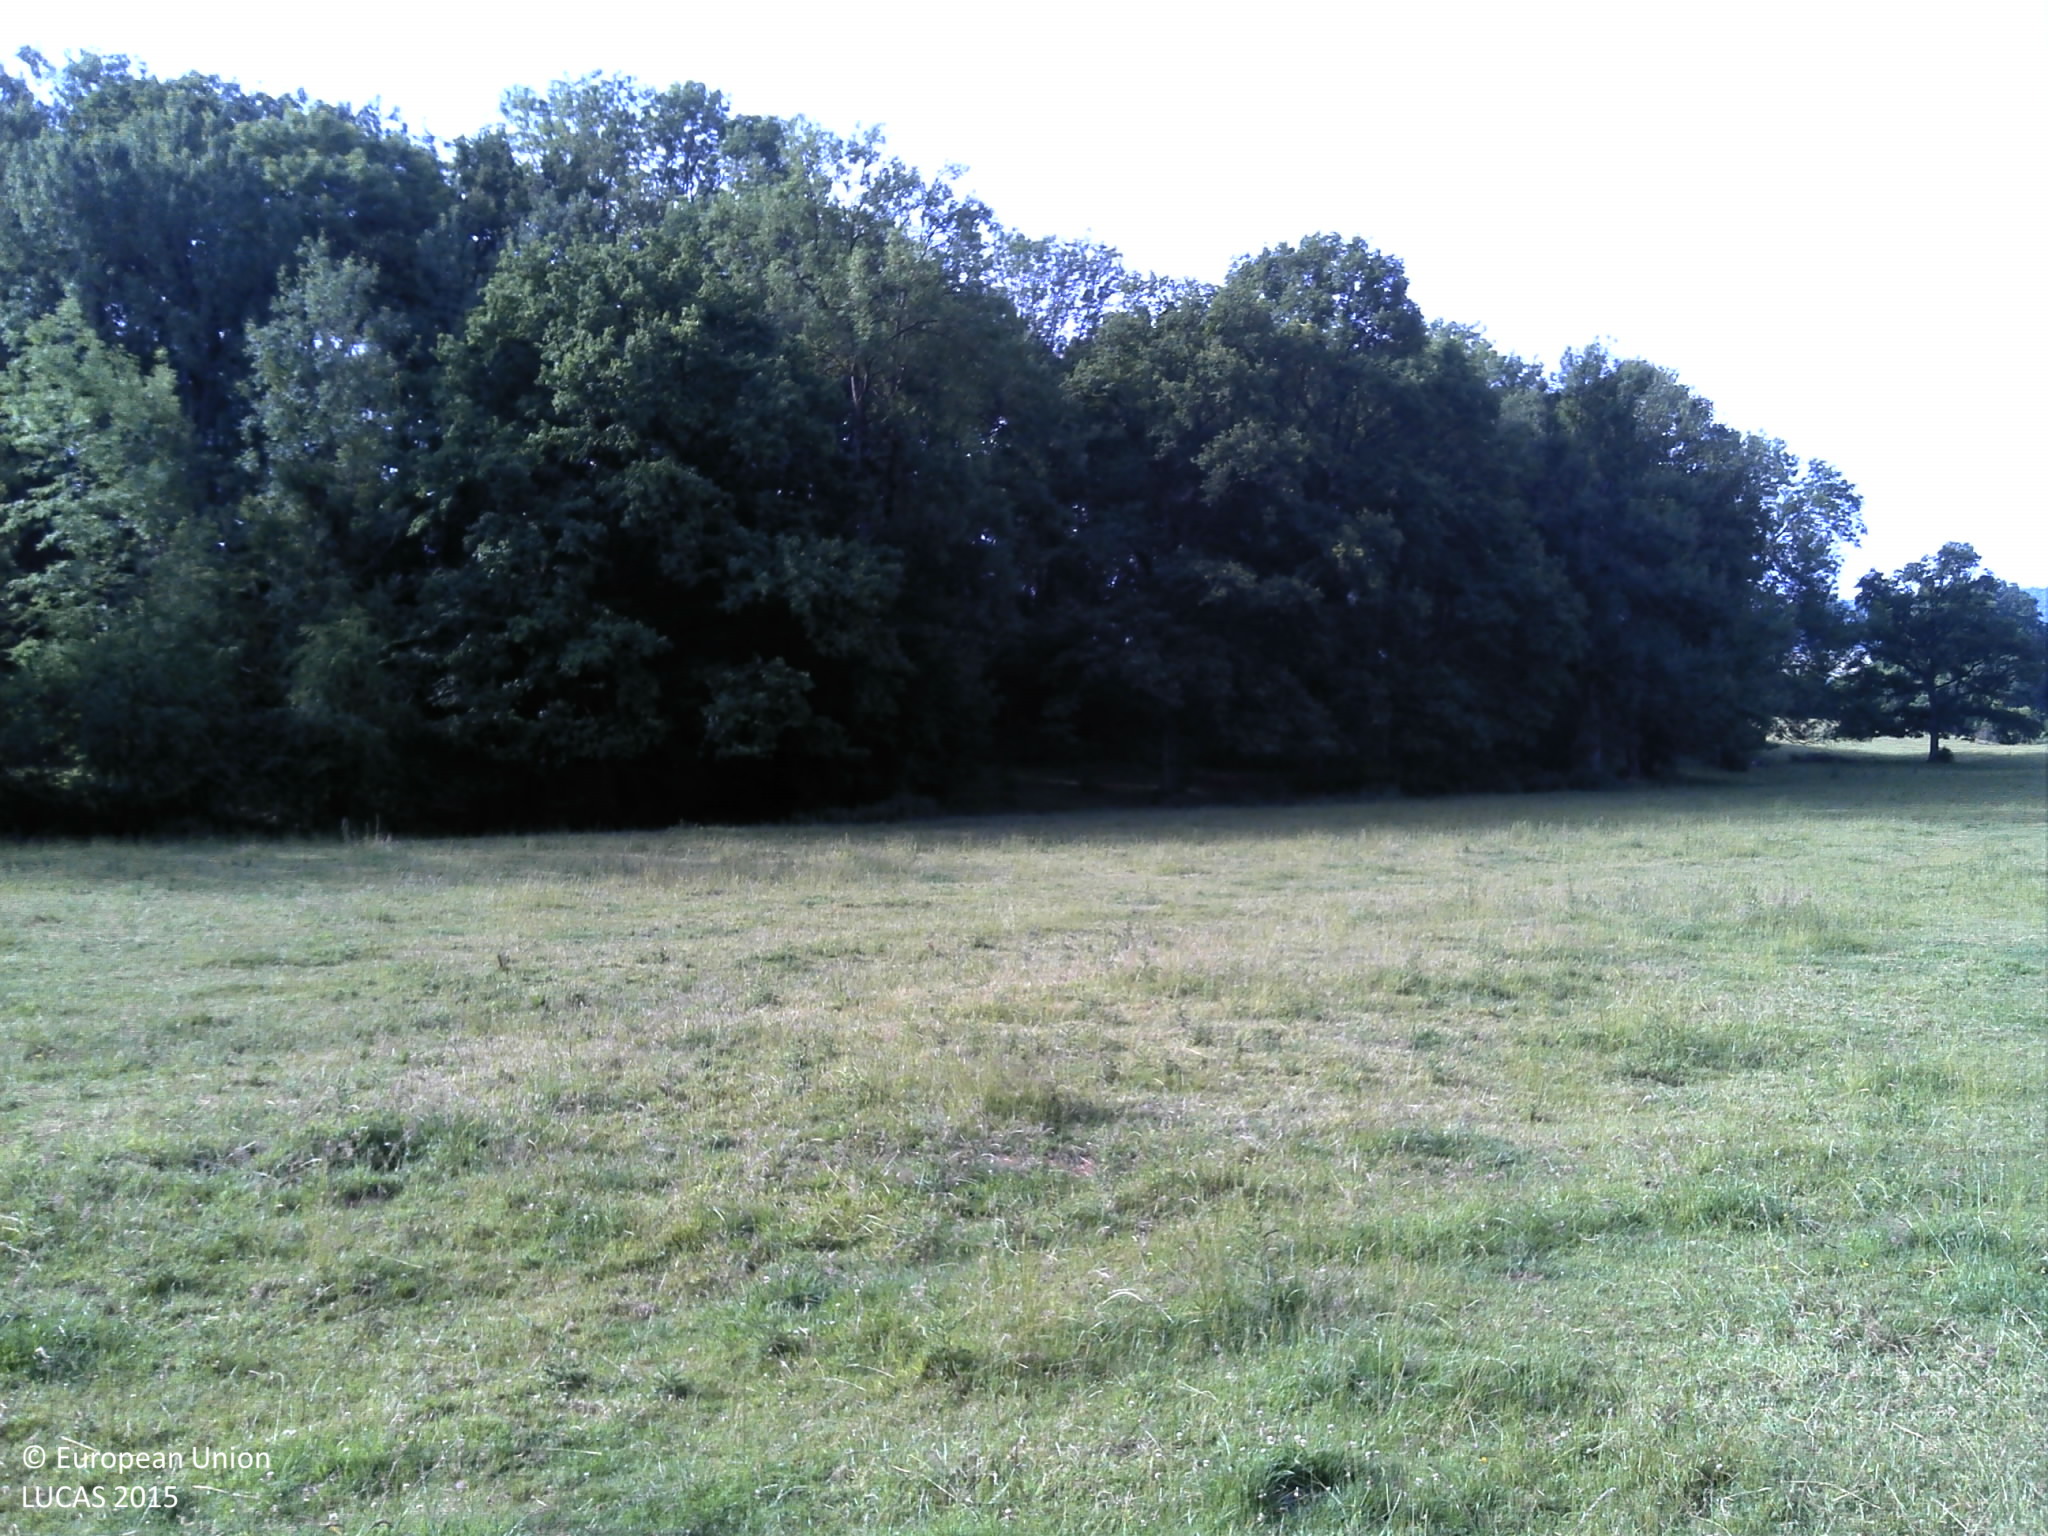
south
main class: Grassland
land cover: Grassland without tree/shrub cover
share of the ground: > 75 %
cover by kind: herbaceous plants 100 %
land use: Agriculture (excluding fallow land and kitchen gardens)
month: June
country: FR
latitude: 49.7064
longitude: 4.8248
